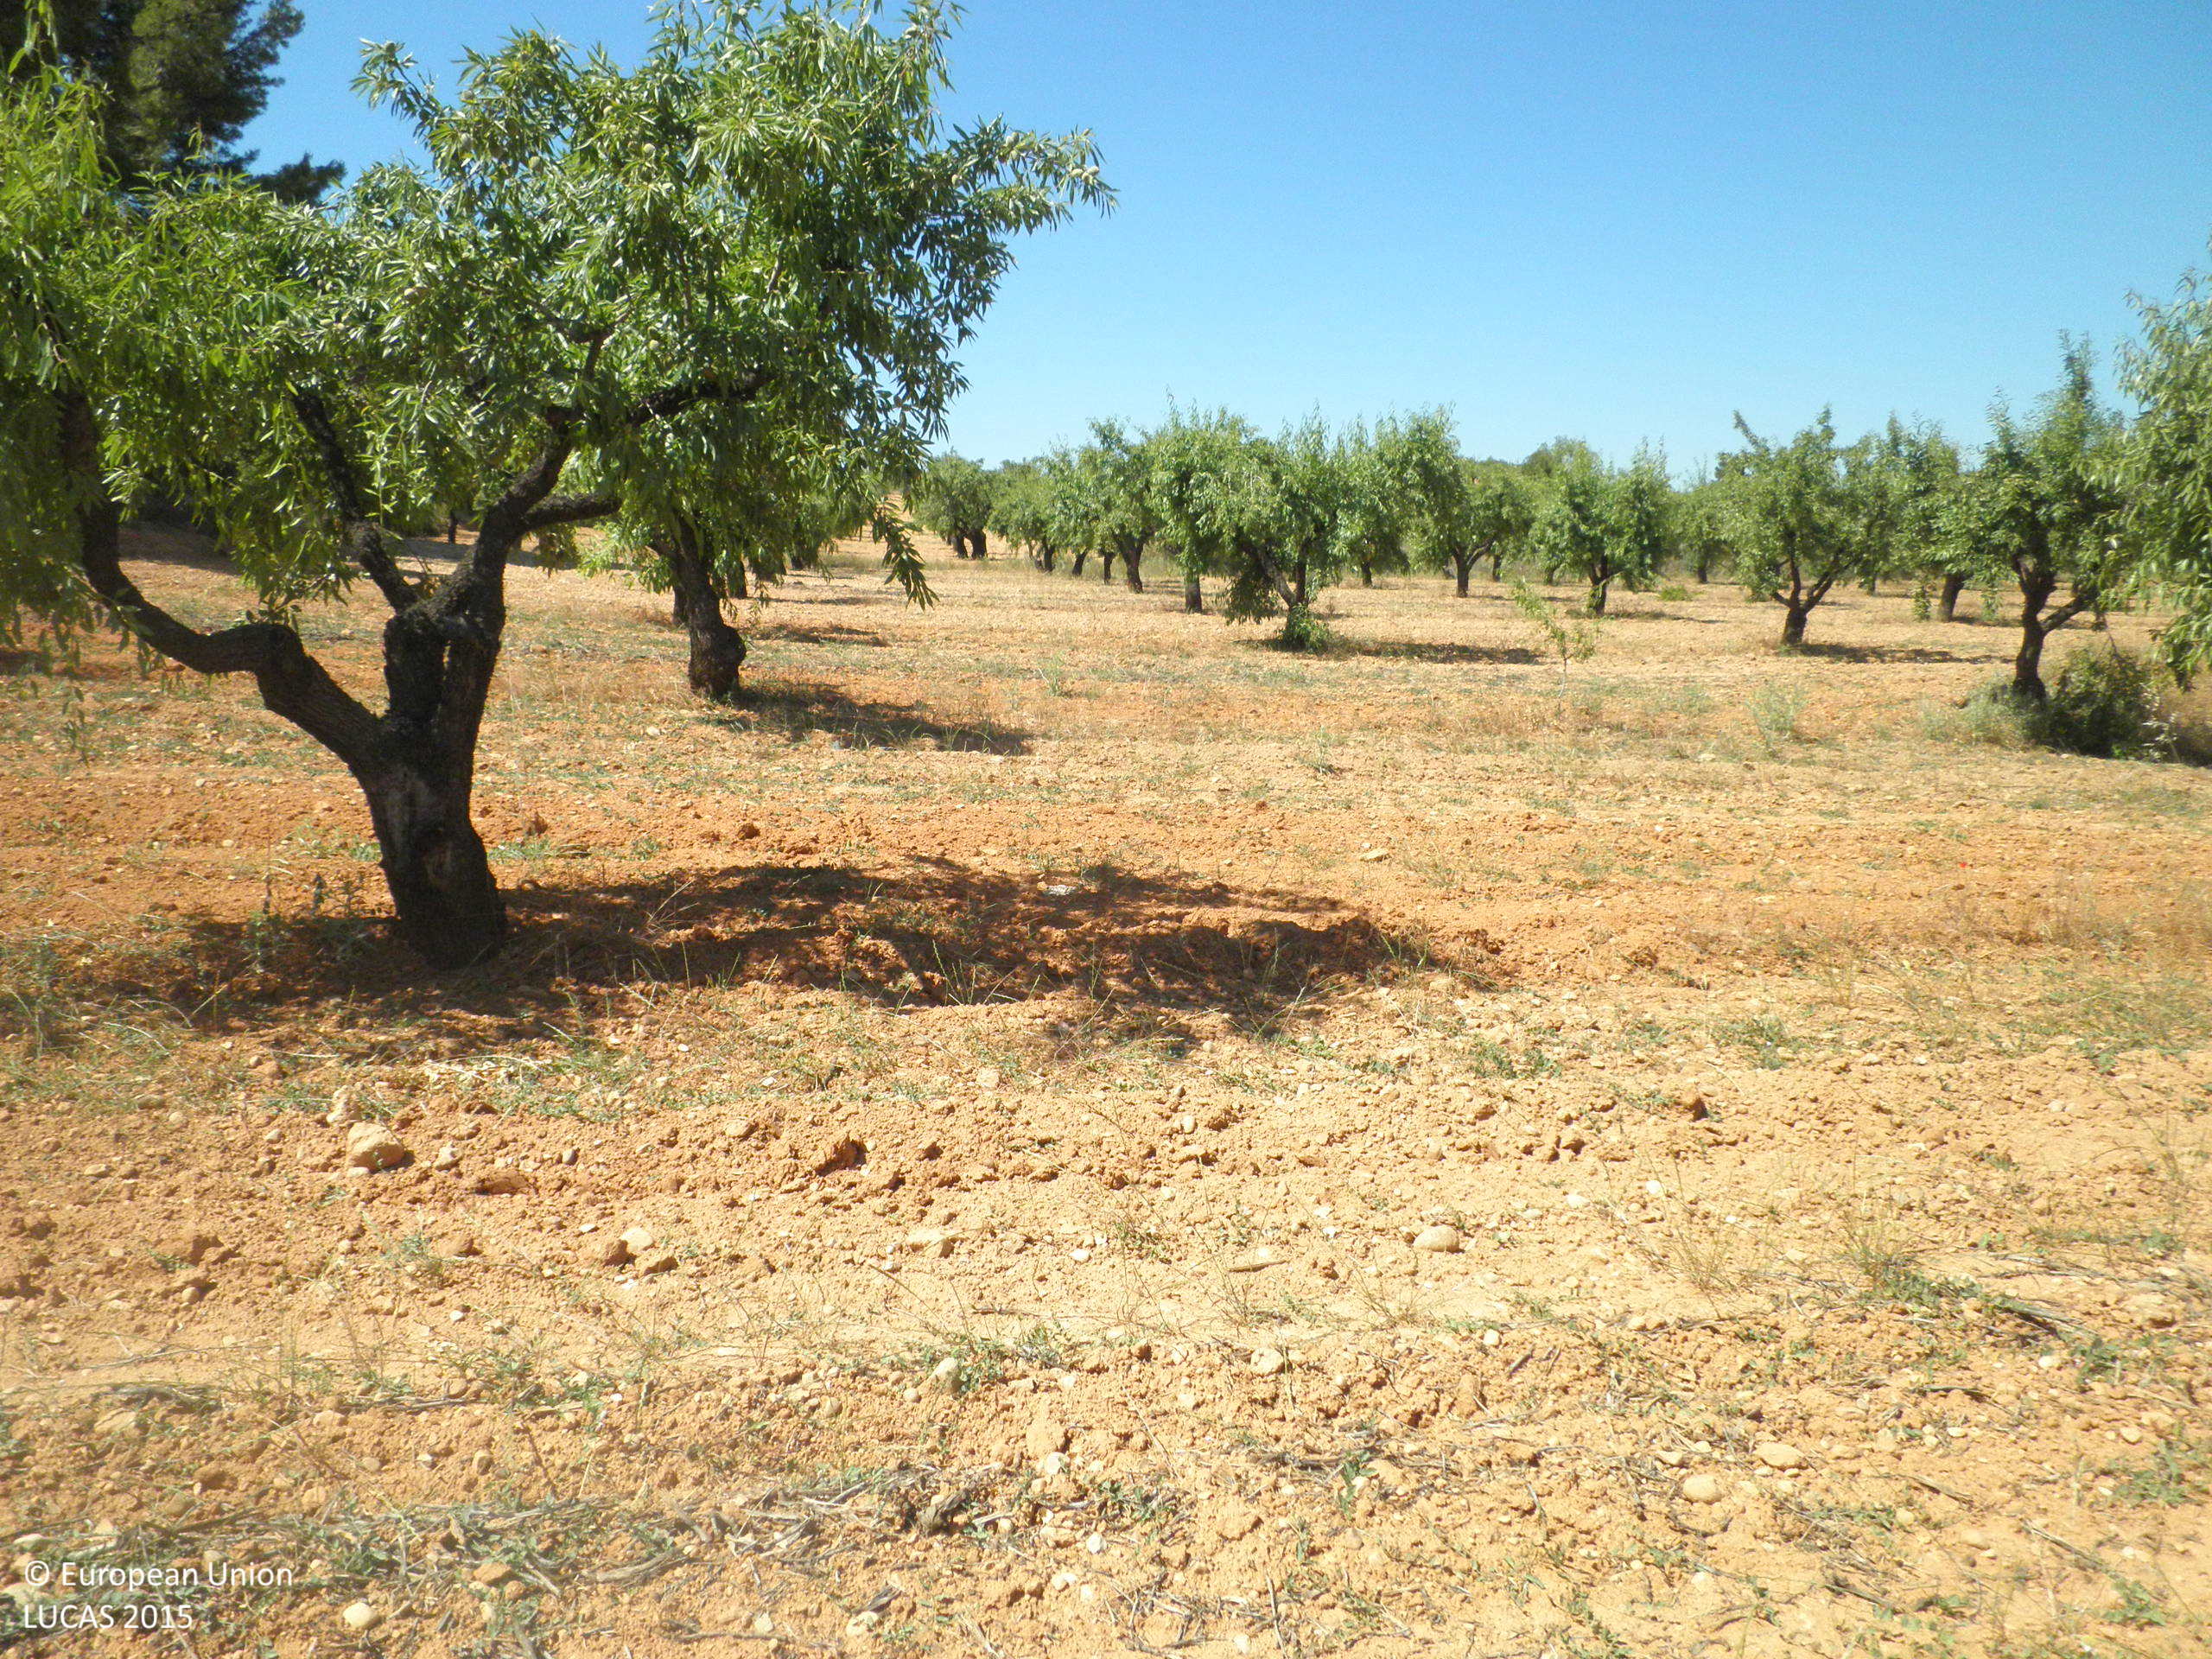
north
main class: Cropland
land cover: Nuts trees
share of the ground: 10 - 25 %
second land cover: Spontaneously vegetated surfaces
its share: < 10 %
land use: Agriculture (excluding fallow land and kitchen gardens)
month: June
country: ES
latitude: 39.5010
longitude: -1.6224
